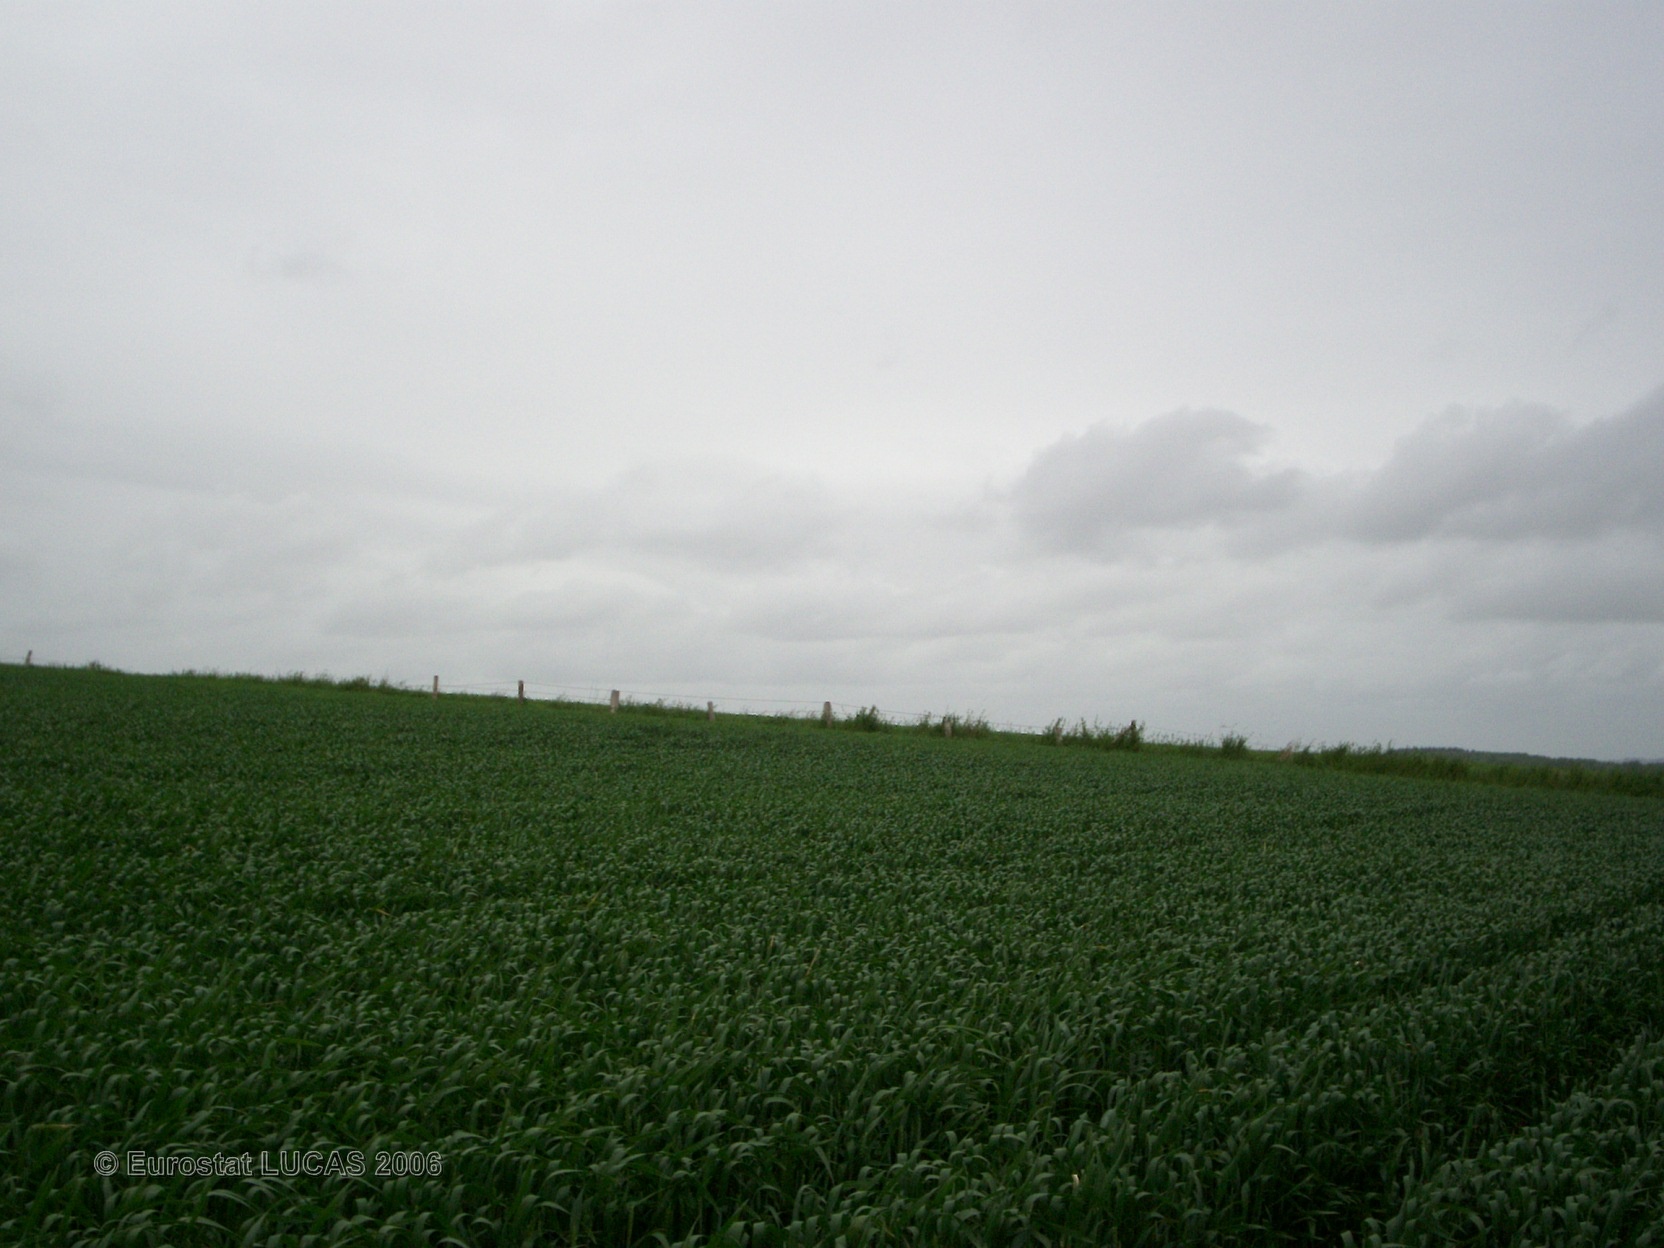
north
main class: Cropland
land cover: Common wheat
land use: Agriculture (excluding fallow land and kitchen gardens)
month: May
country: FR
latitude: 48.5719
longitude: -1.2523
